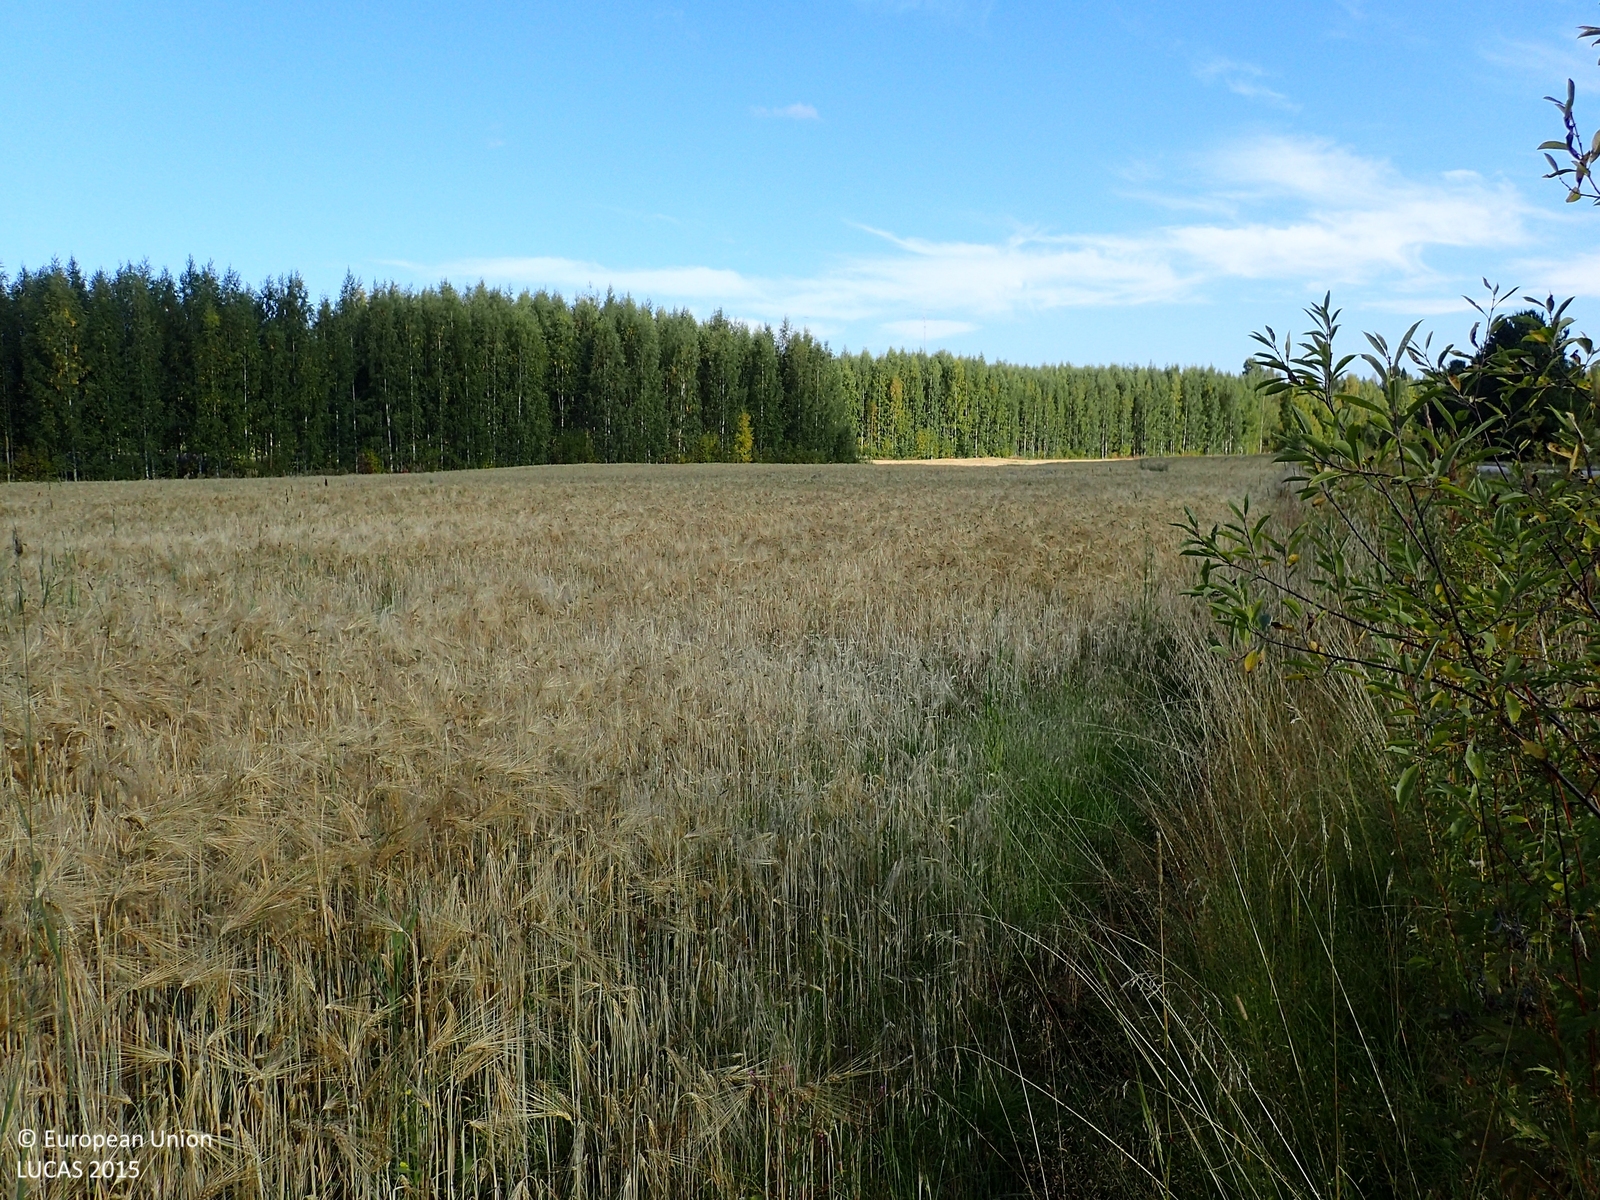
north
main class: Cropland
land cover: Barley
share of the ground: > 75 %
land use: Agriculture (excluding fallow land and kitchen gardens)
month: September
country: FI
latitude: 62.9775
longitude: 25.5557
